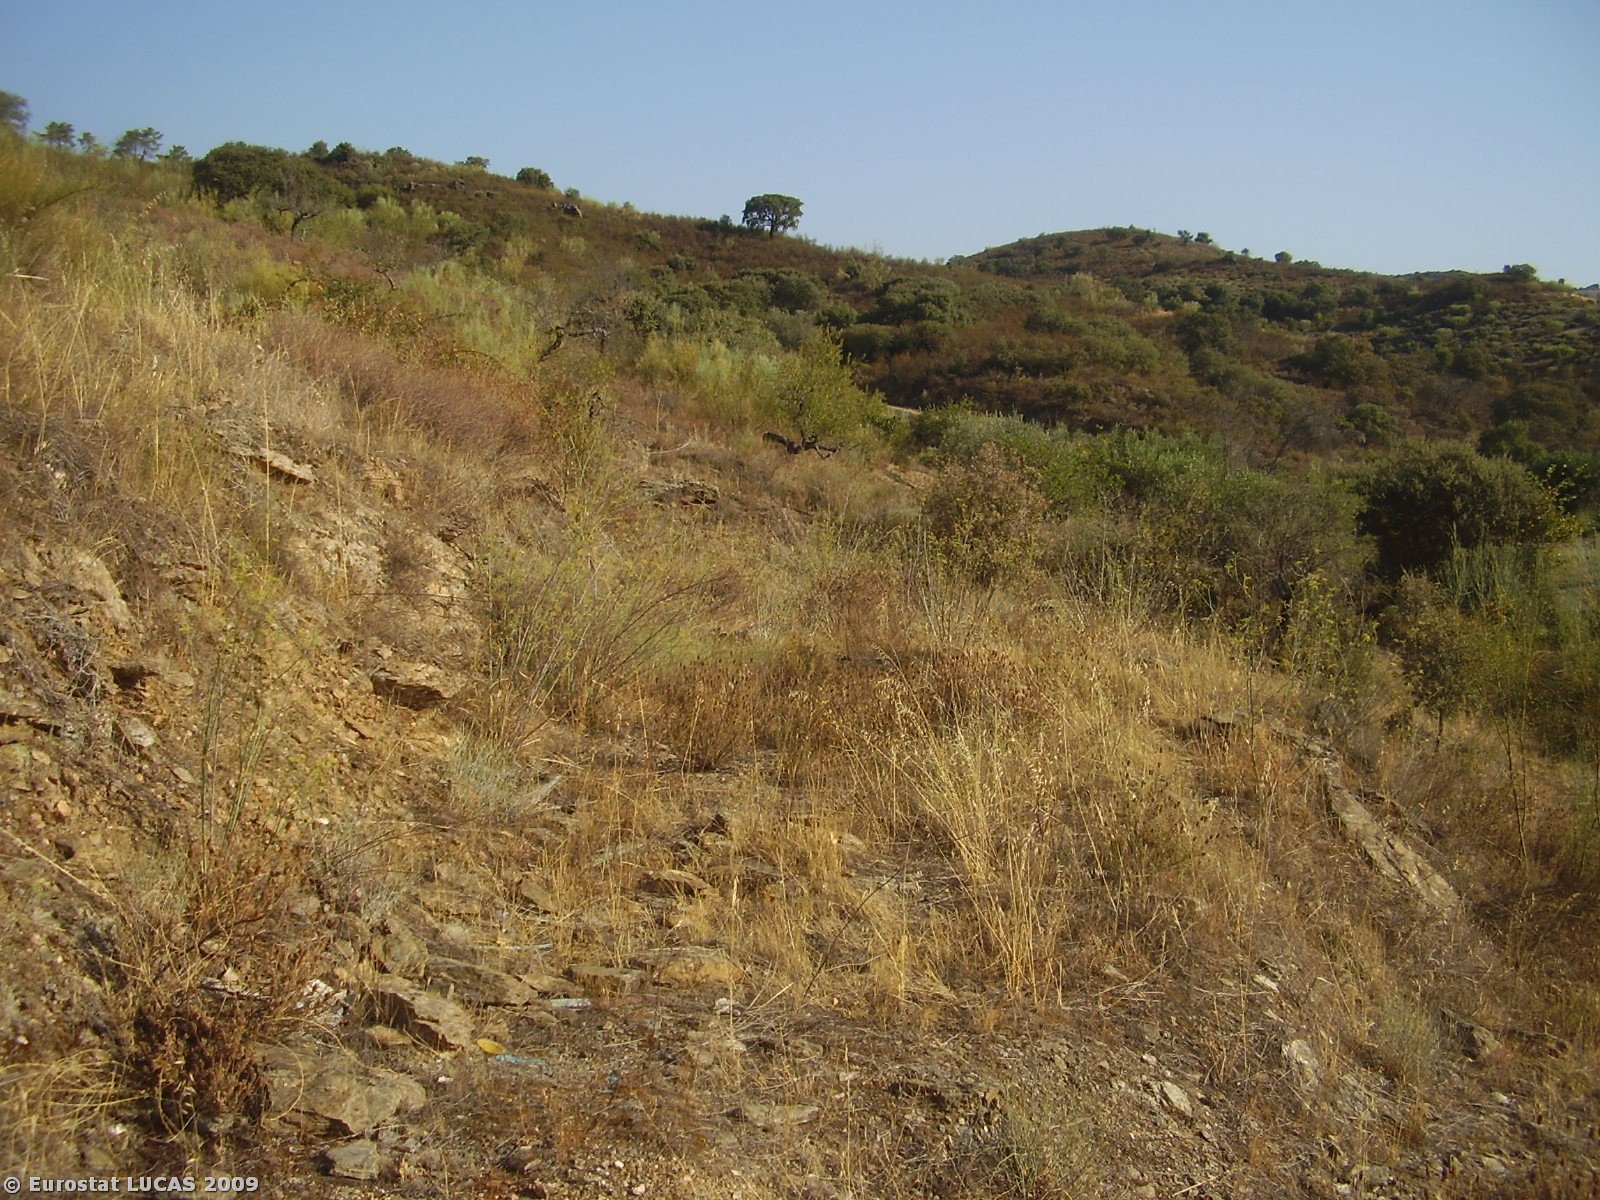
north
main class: Grassland
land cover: Spontaneously vegetated surfaces
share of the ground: > 75 %
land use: Fallow land
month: August
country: PT
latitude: 41.3652
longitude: -7.0291
